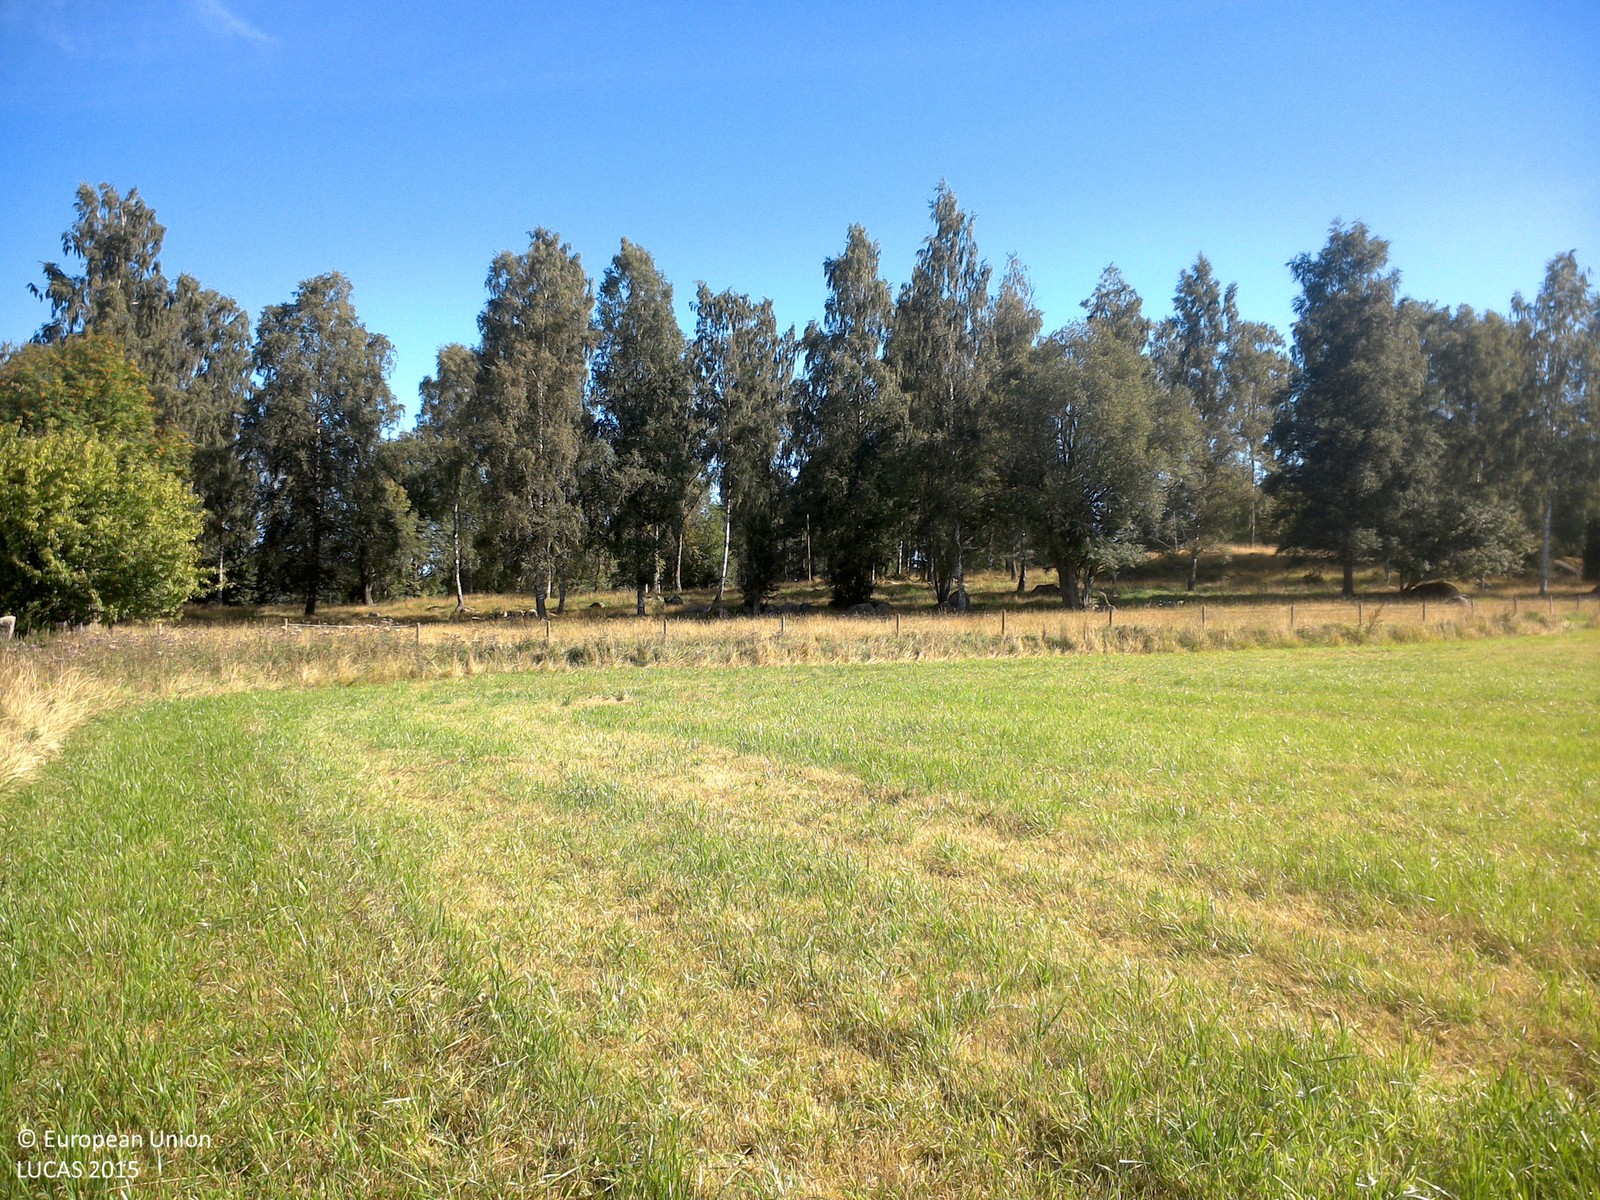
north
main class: Cropland
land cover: Other leguminous and mixtures for fodder
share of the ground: > 75 %
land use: Agriculture (excluding fallow land and kitchen gardens)
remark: Harvested field
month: August
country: SE
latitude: 58.2545
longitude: 14.9530
